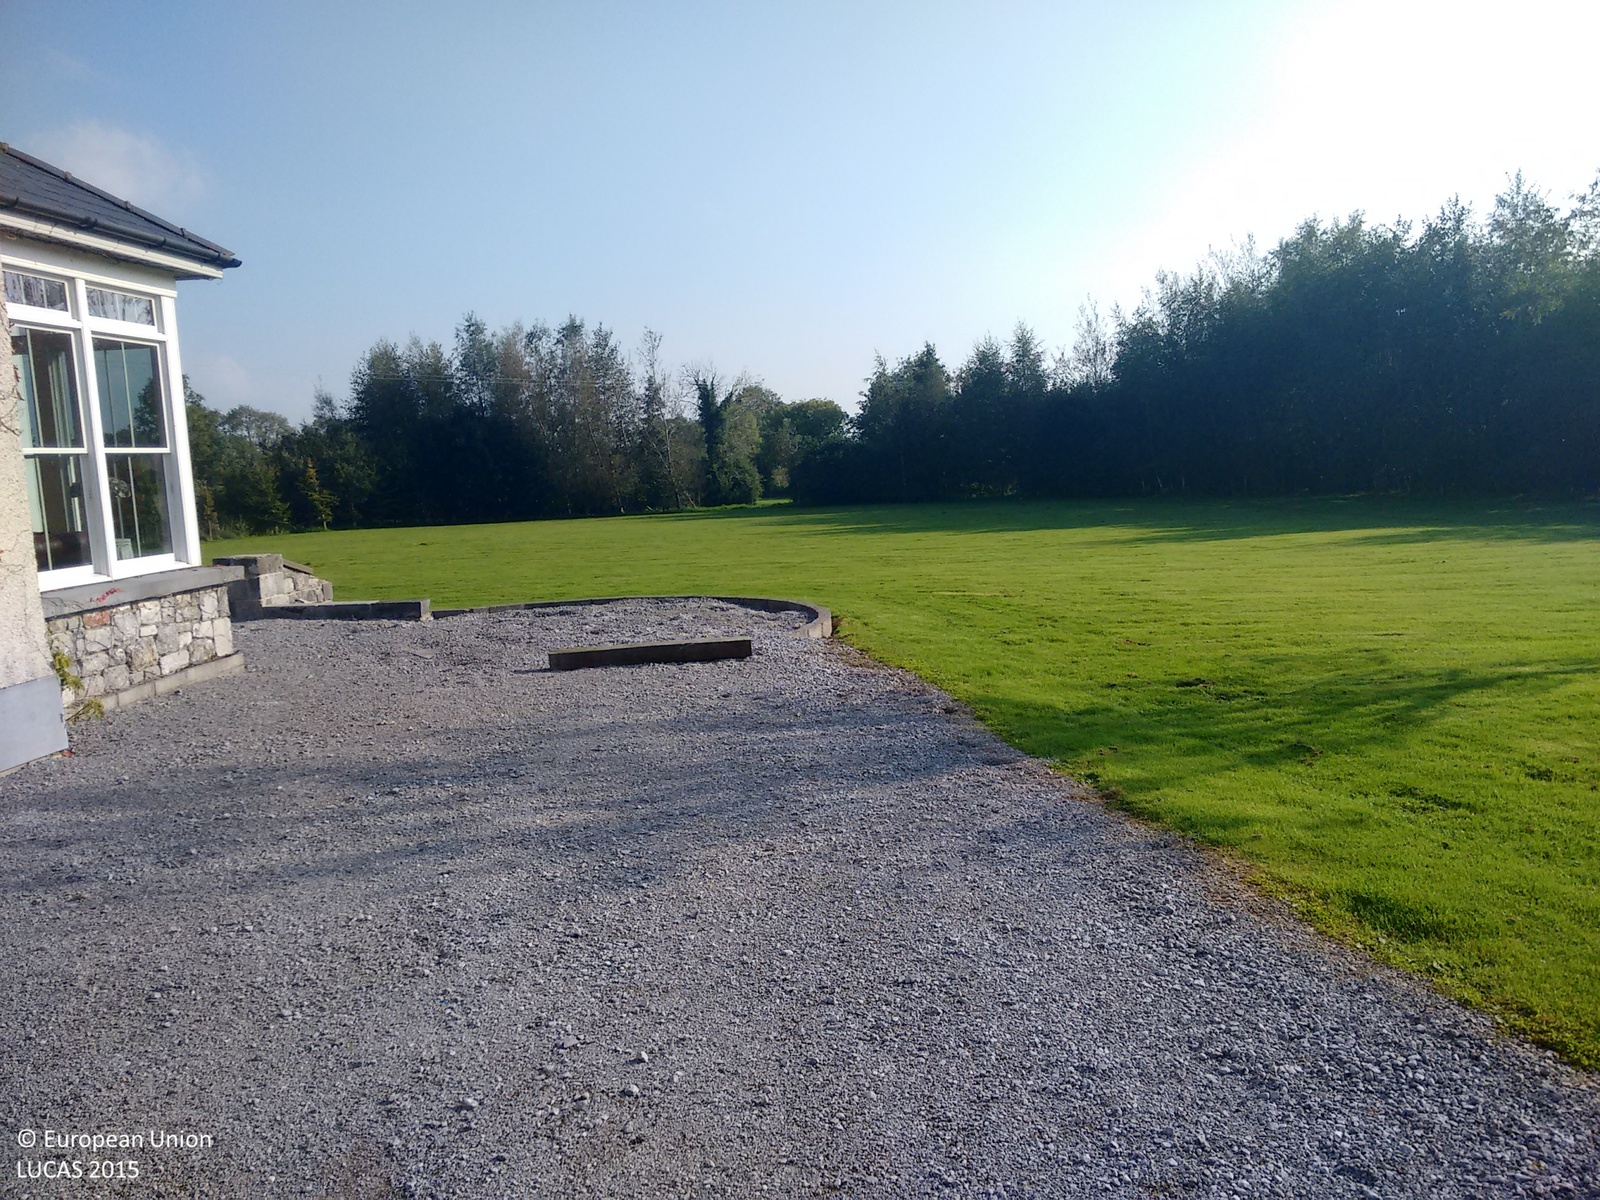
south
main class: Grassland
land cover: Grassland without tree/shrub cover
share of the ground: > 75 %
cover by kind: herbaceous plants 100 %
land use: Residential
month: October
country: IE
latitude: 52.4355
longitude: -9.0885
